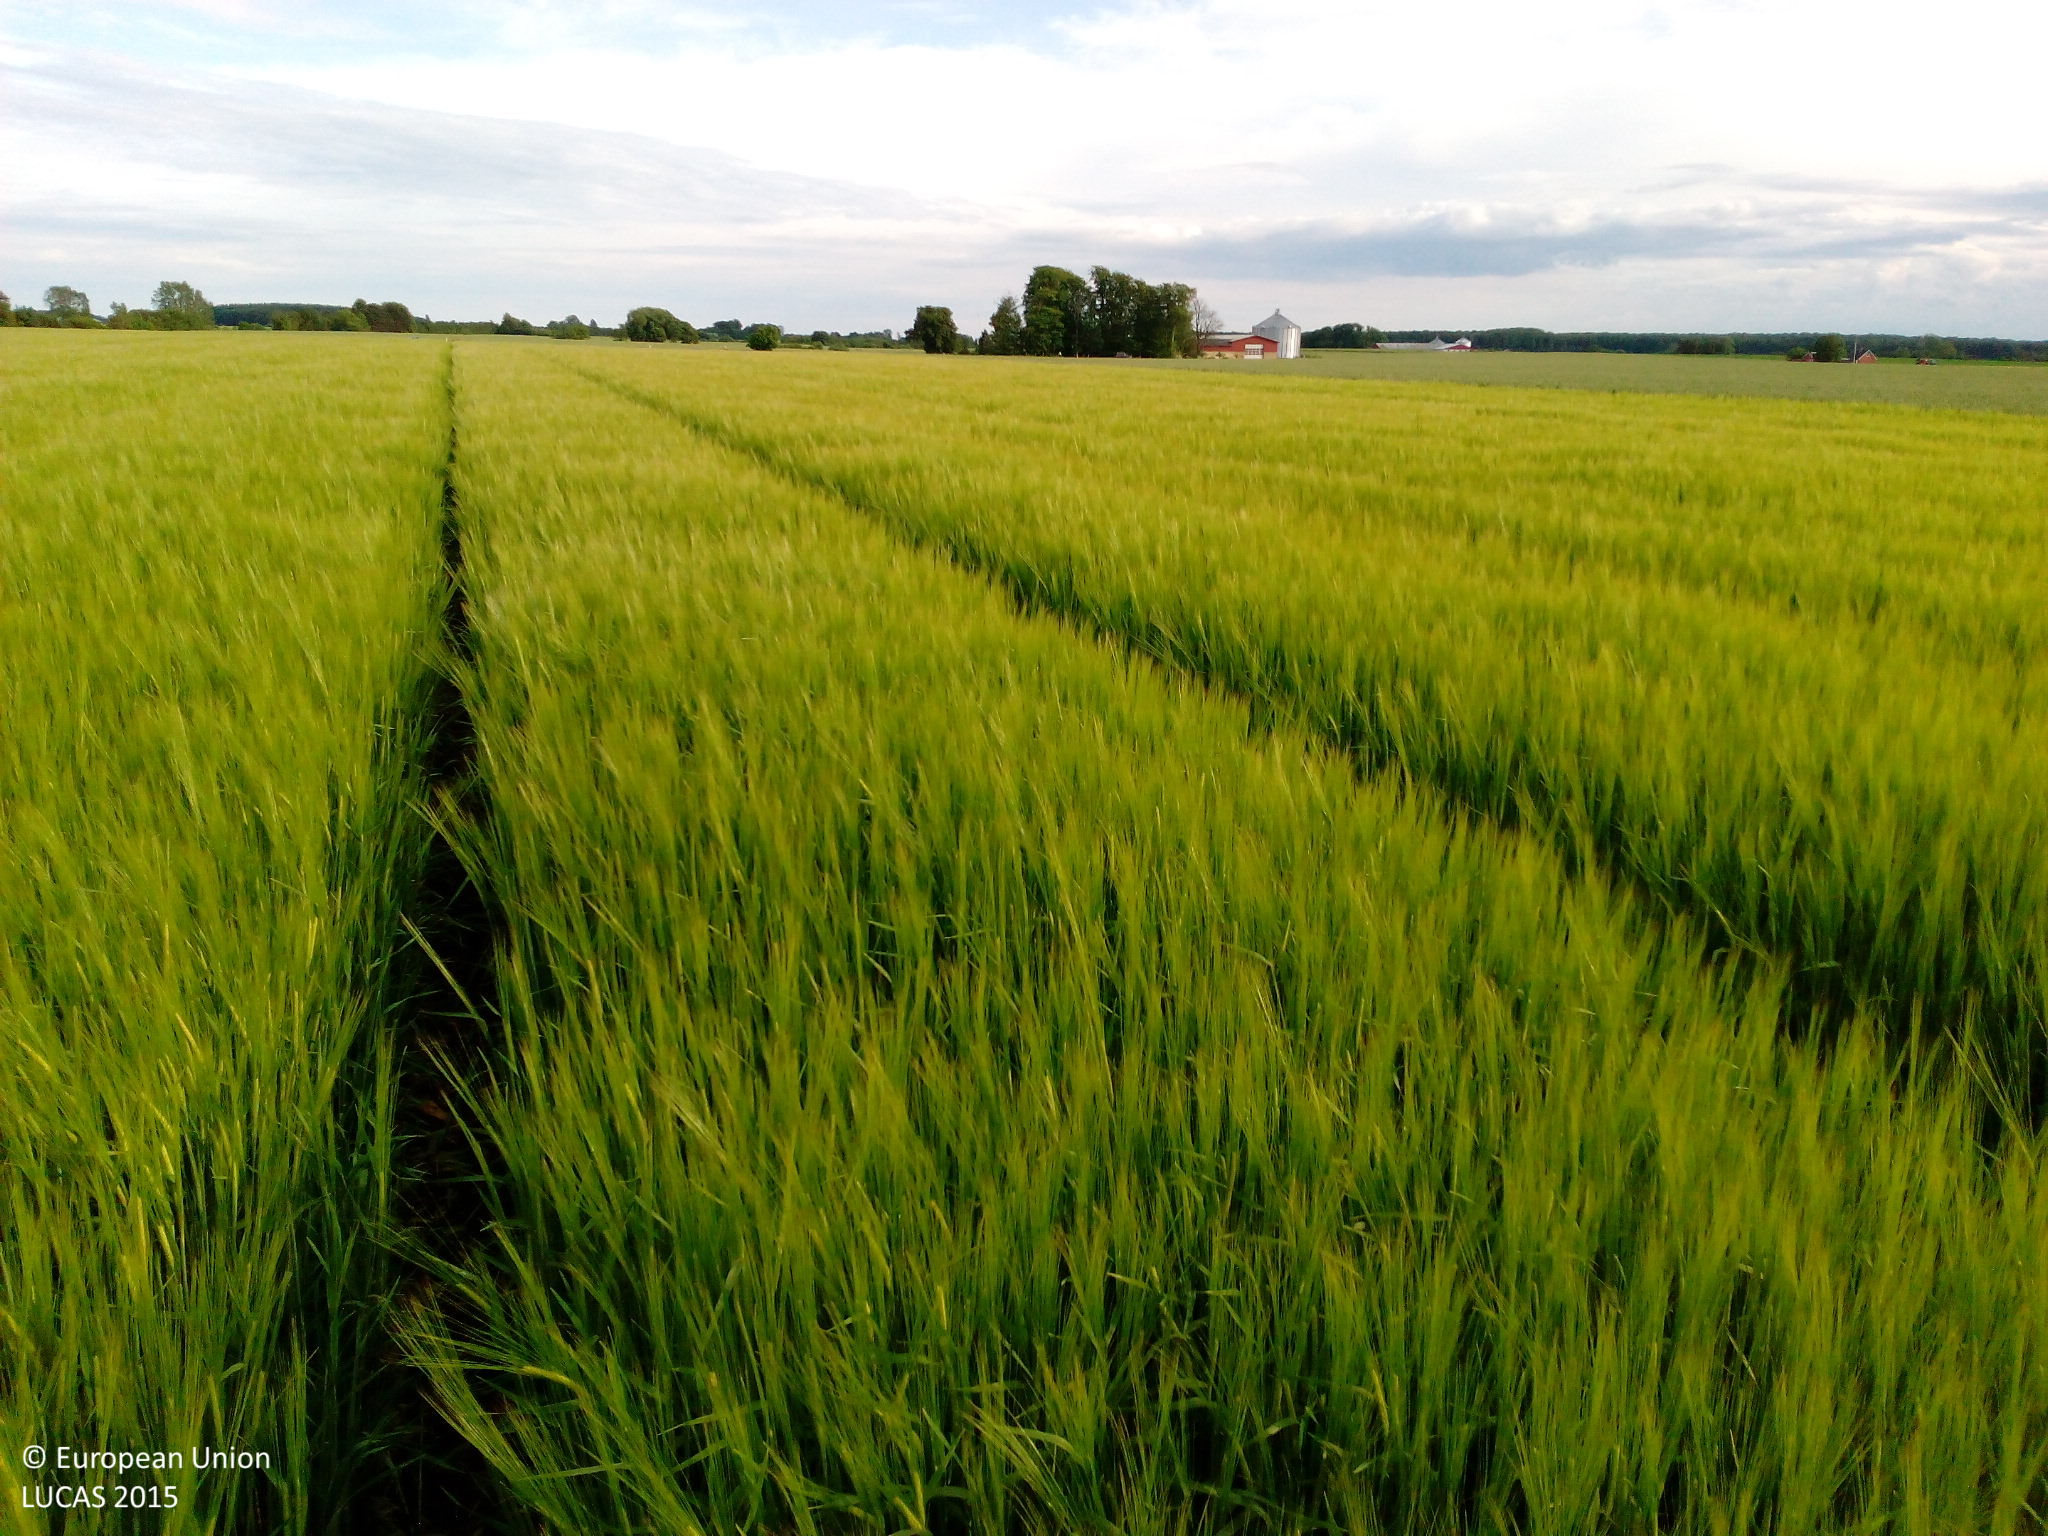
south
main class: Cropland
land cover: Barley
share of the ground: > 75 %
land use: Agriculture (excluding fallow land and kitchen gardens)
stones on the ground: < 10 %
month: June
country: DK
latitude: 54.7957
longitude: 11.4144
